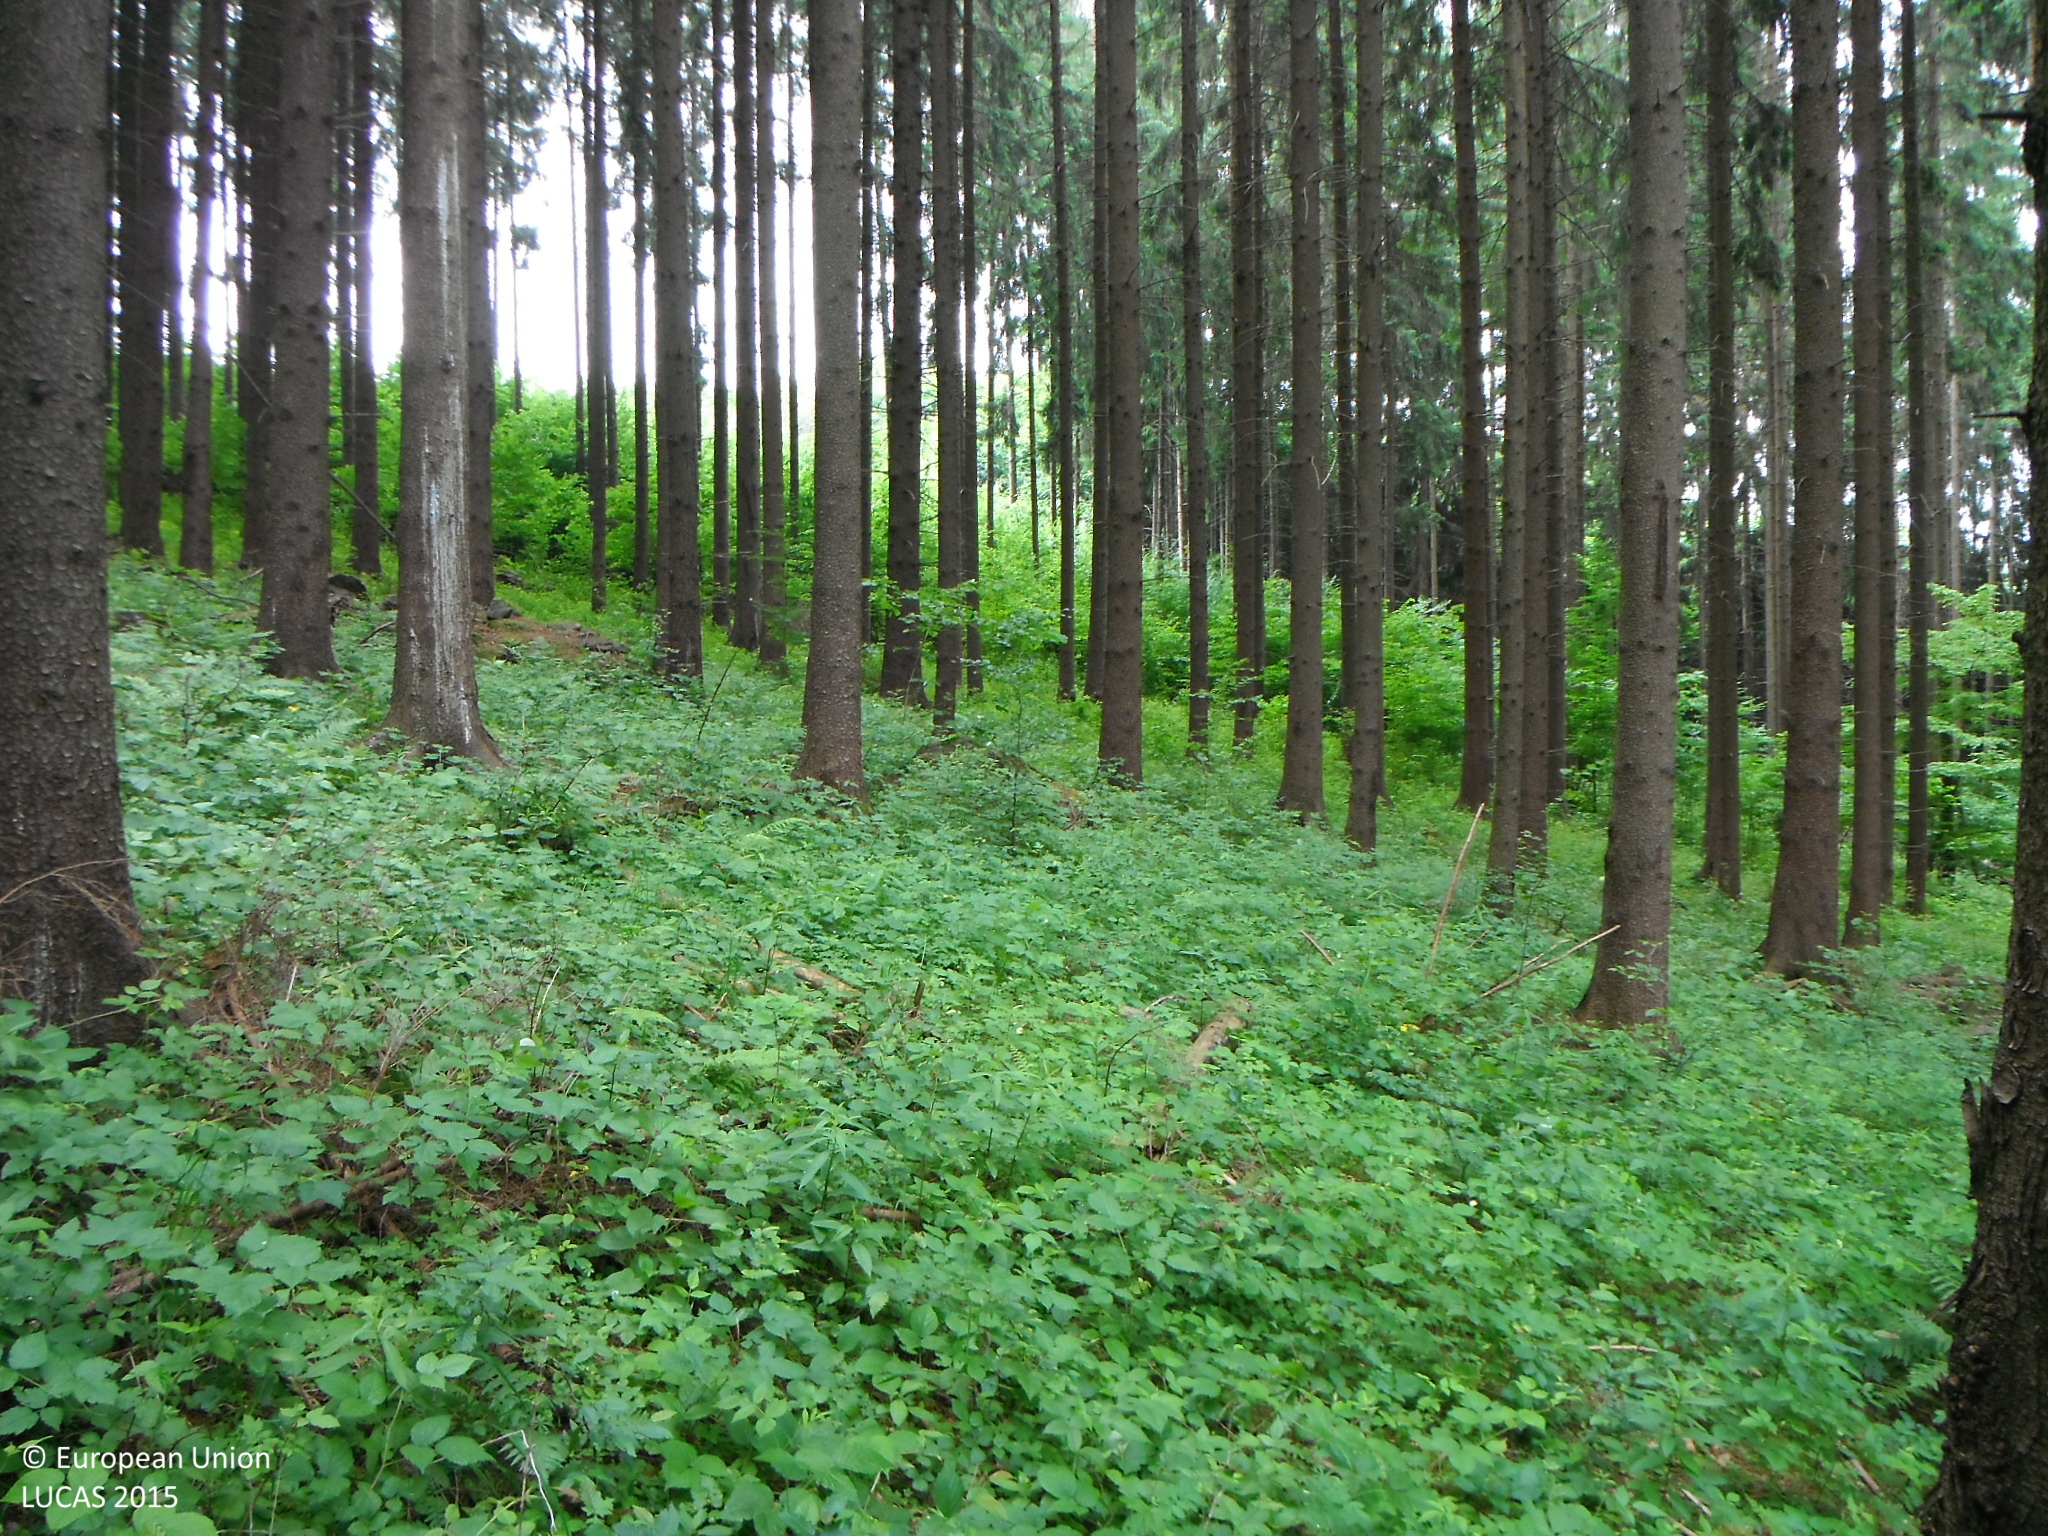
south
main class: Woodland
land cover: Spruce dominated coniferous woodland
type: alpine coniferous forest
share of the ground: > 75 %
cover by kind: coniferous forest trees 90 %, shrubs 5 %, herbaceous plants 5 %
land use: Forestry
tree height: > 5 m
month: June
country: SK
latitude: 48.6206
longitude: 19.3709
